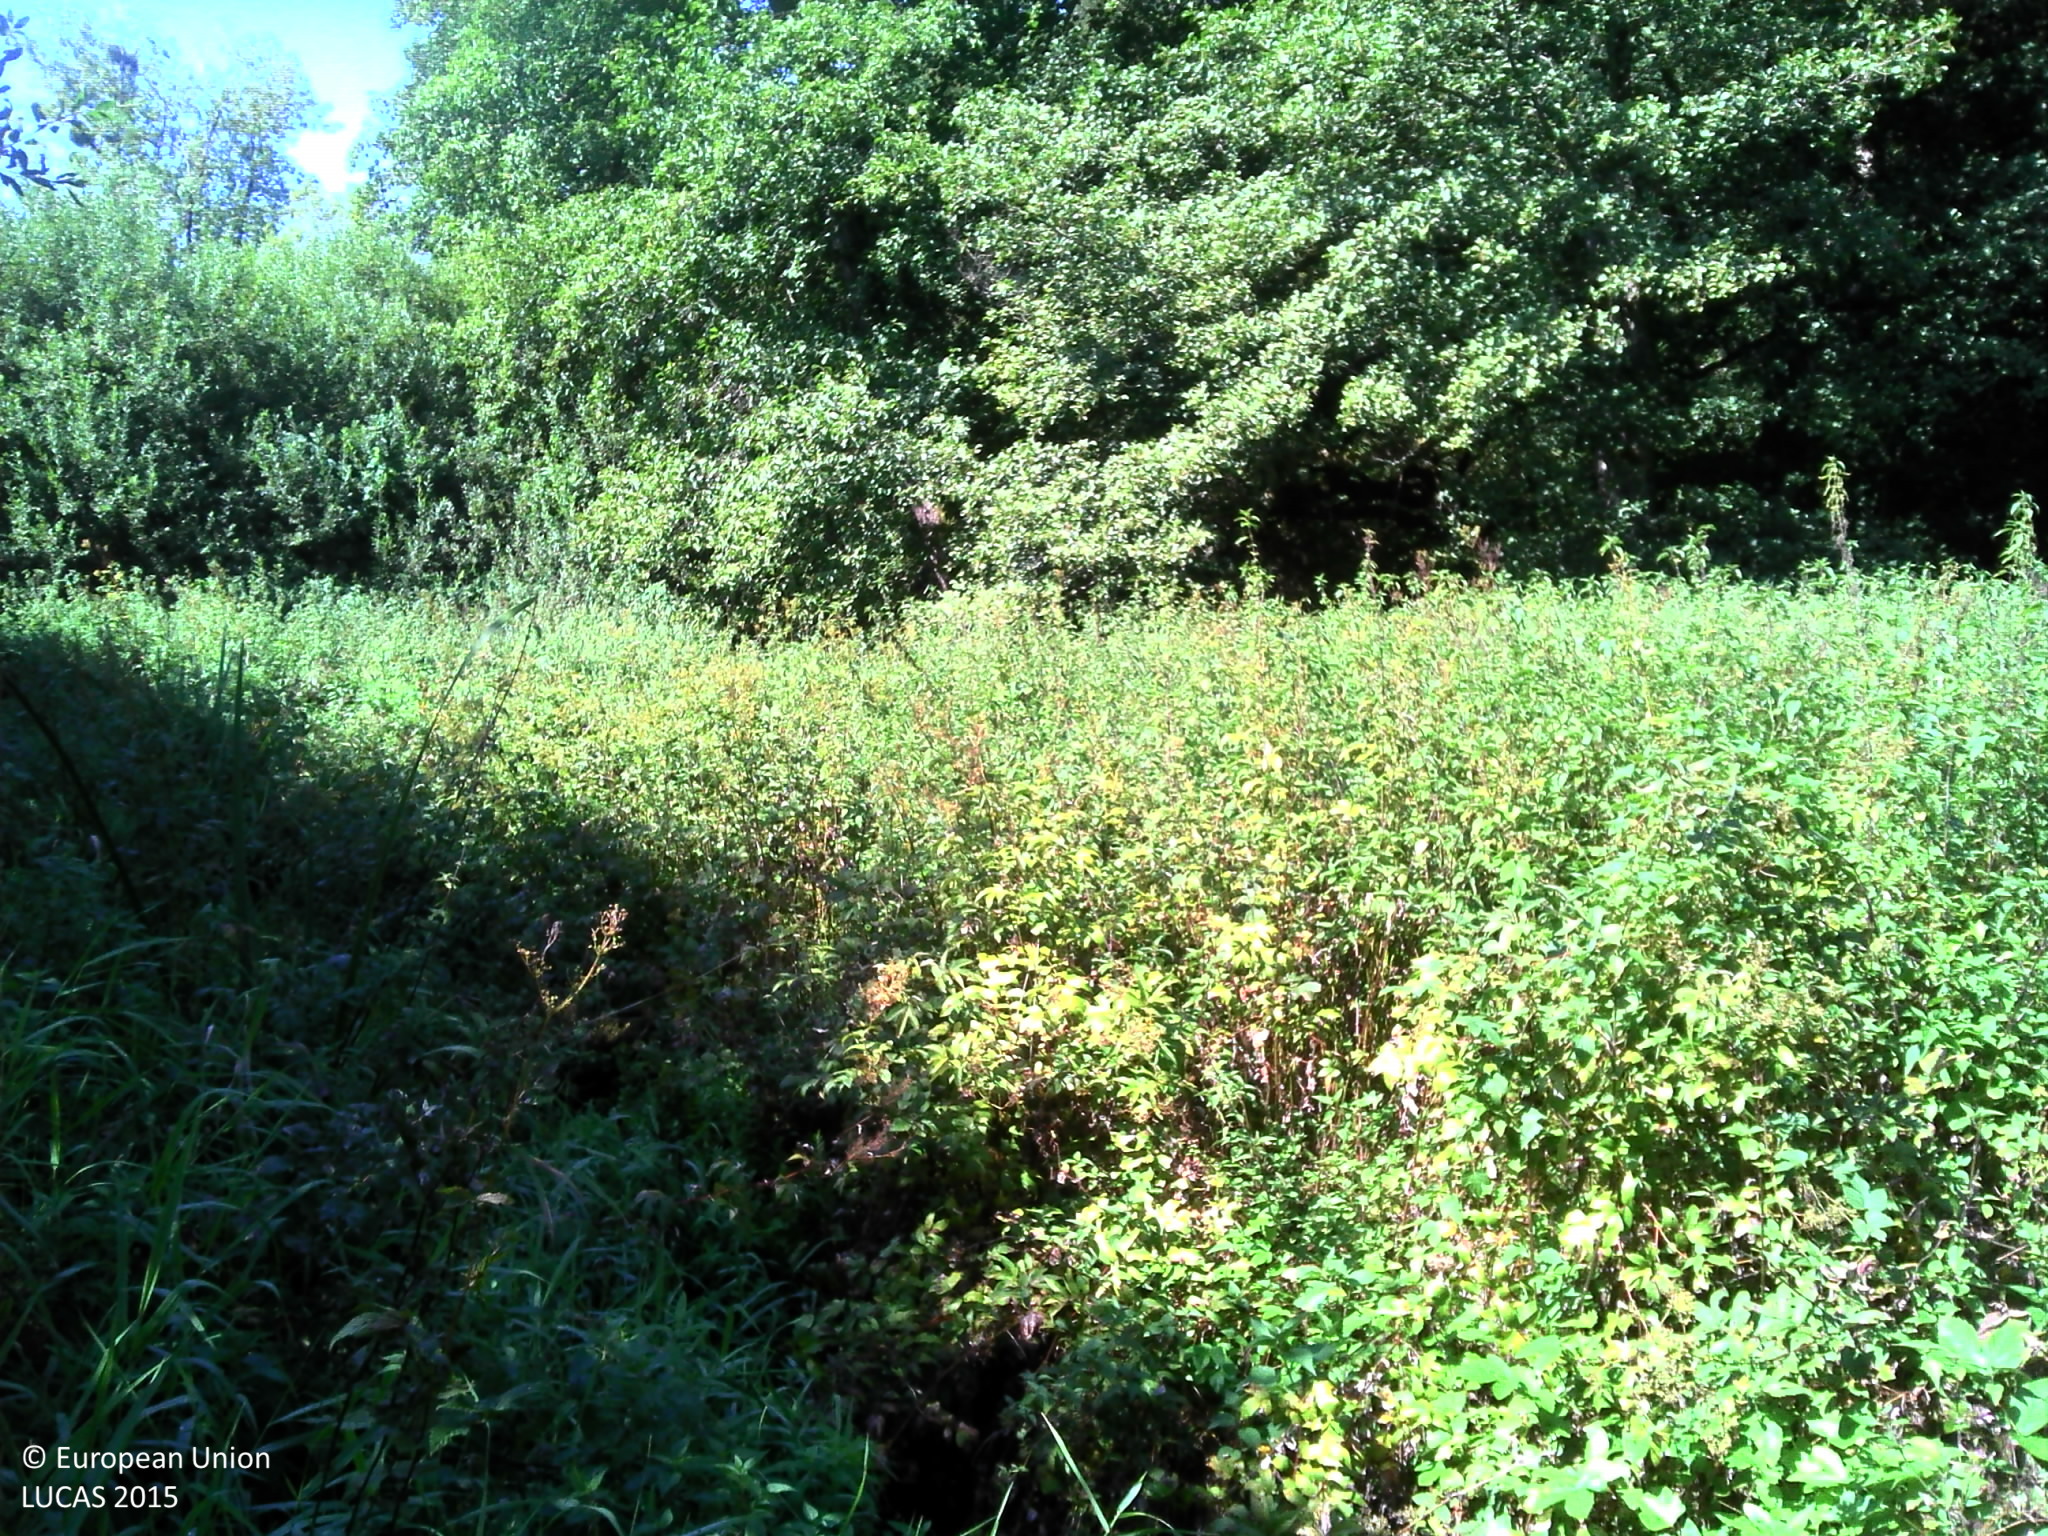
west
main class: Woodland
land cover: Broadleaved woodland
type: floodplain forest
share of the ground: > 75 %
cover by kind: broadleaved forest trees 60 %, shrubs 30 %, herbaceous plants 10 %
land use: Semi-natural and natural areas not in use
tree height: > 5 m
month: September
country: FR
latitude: 47.2764
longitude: 6.2343
